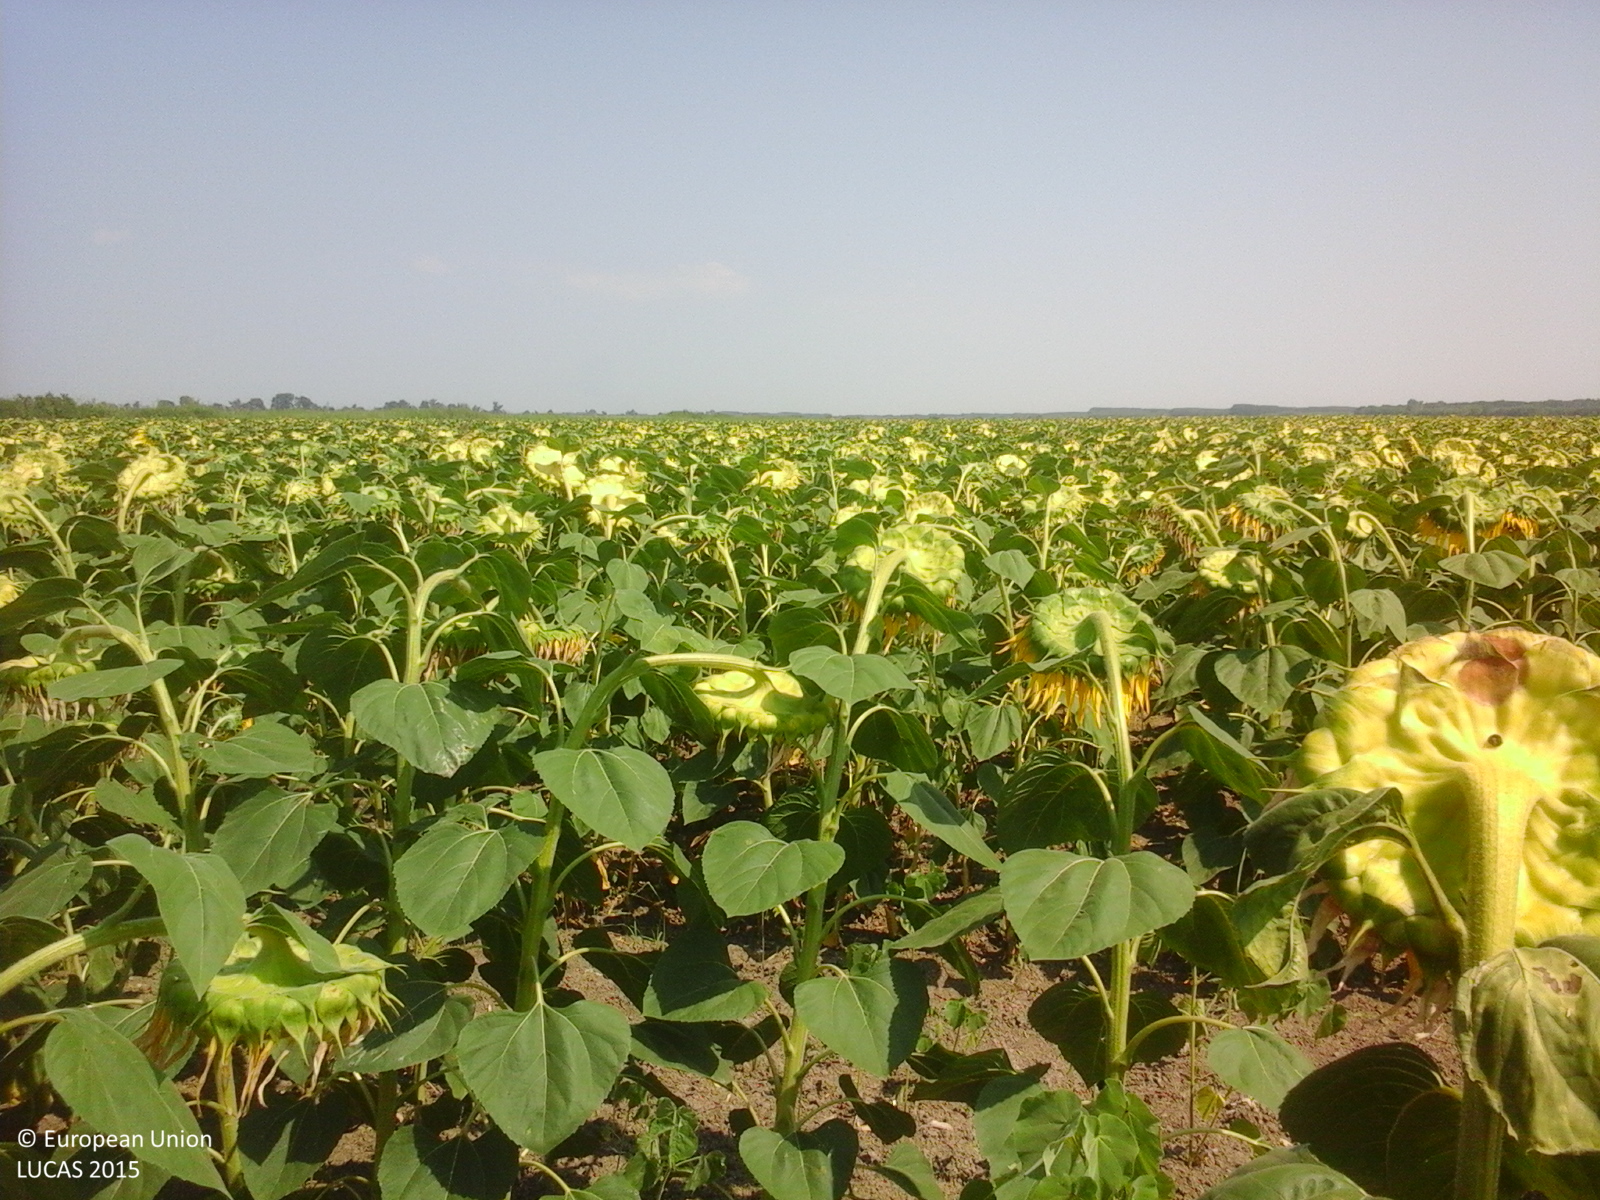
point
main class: Cropland
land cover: Sunflower
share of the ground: > 75 %
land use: Agriculture (excluding fallow land and kitchen gardens)
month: July
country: RO
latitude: 45.4124
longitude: 27.8082
